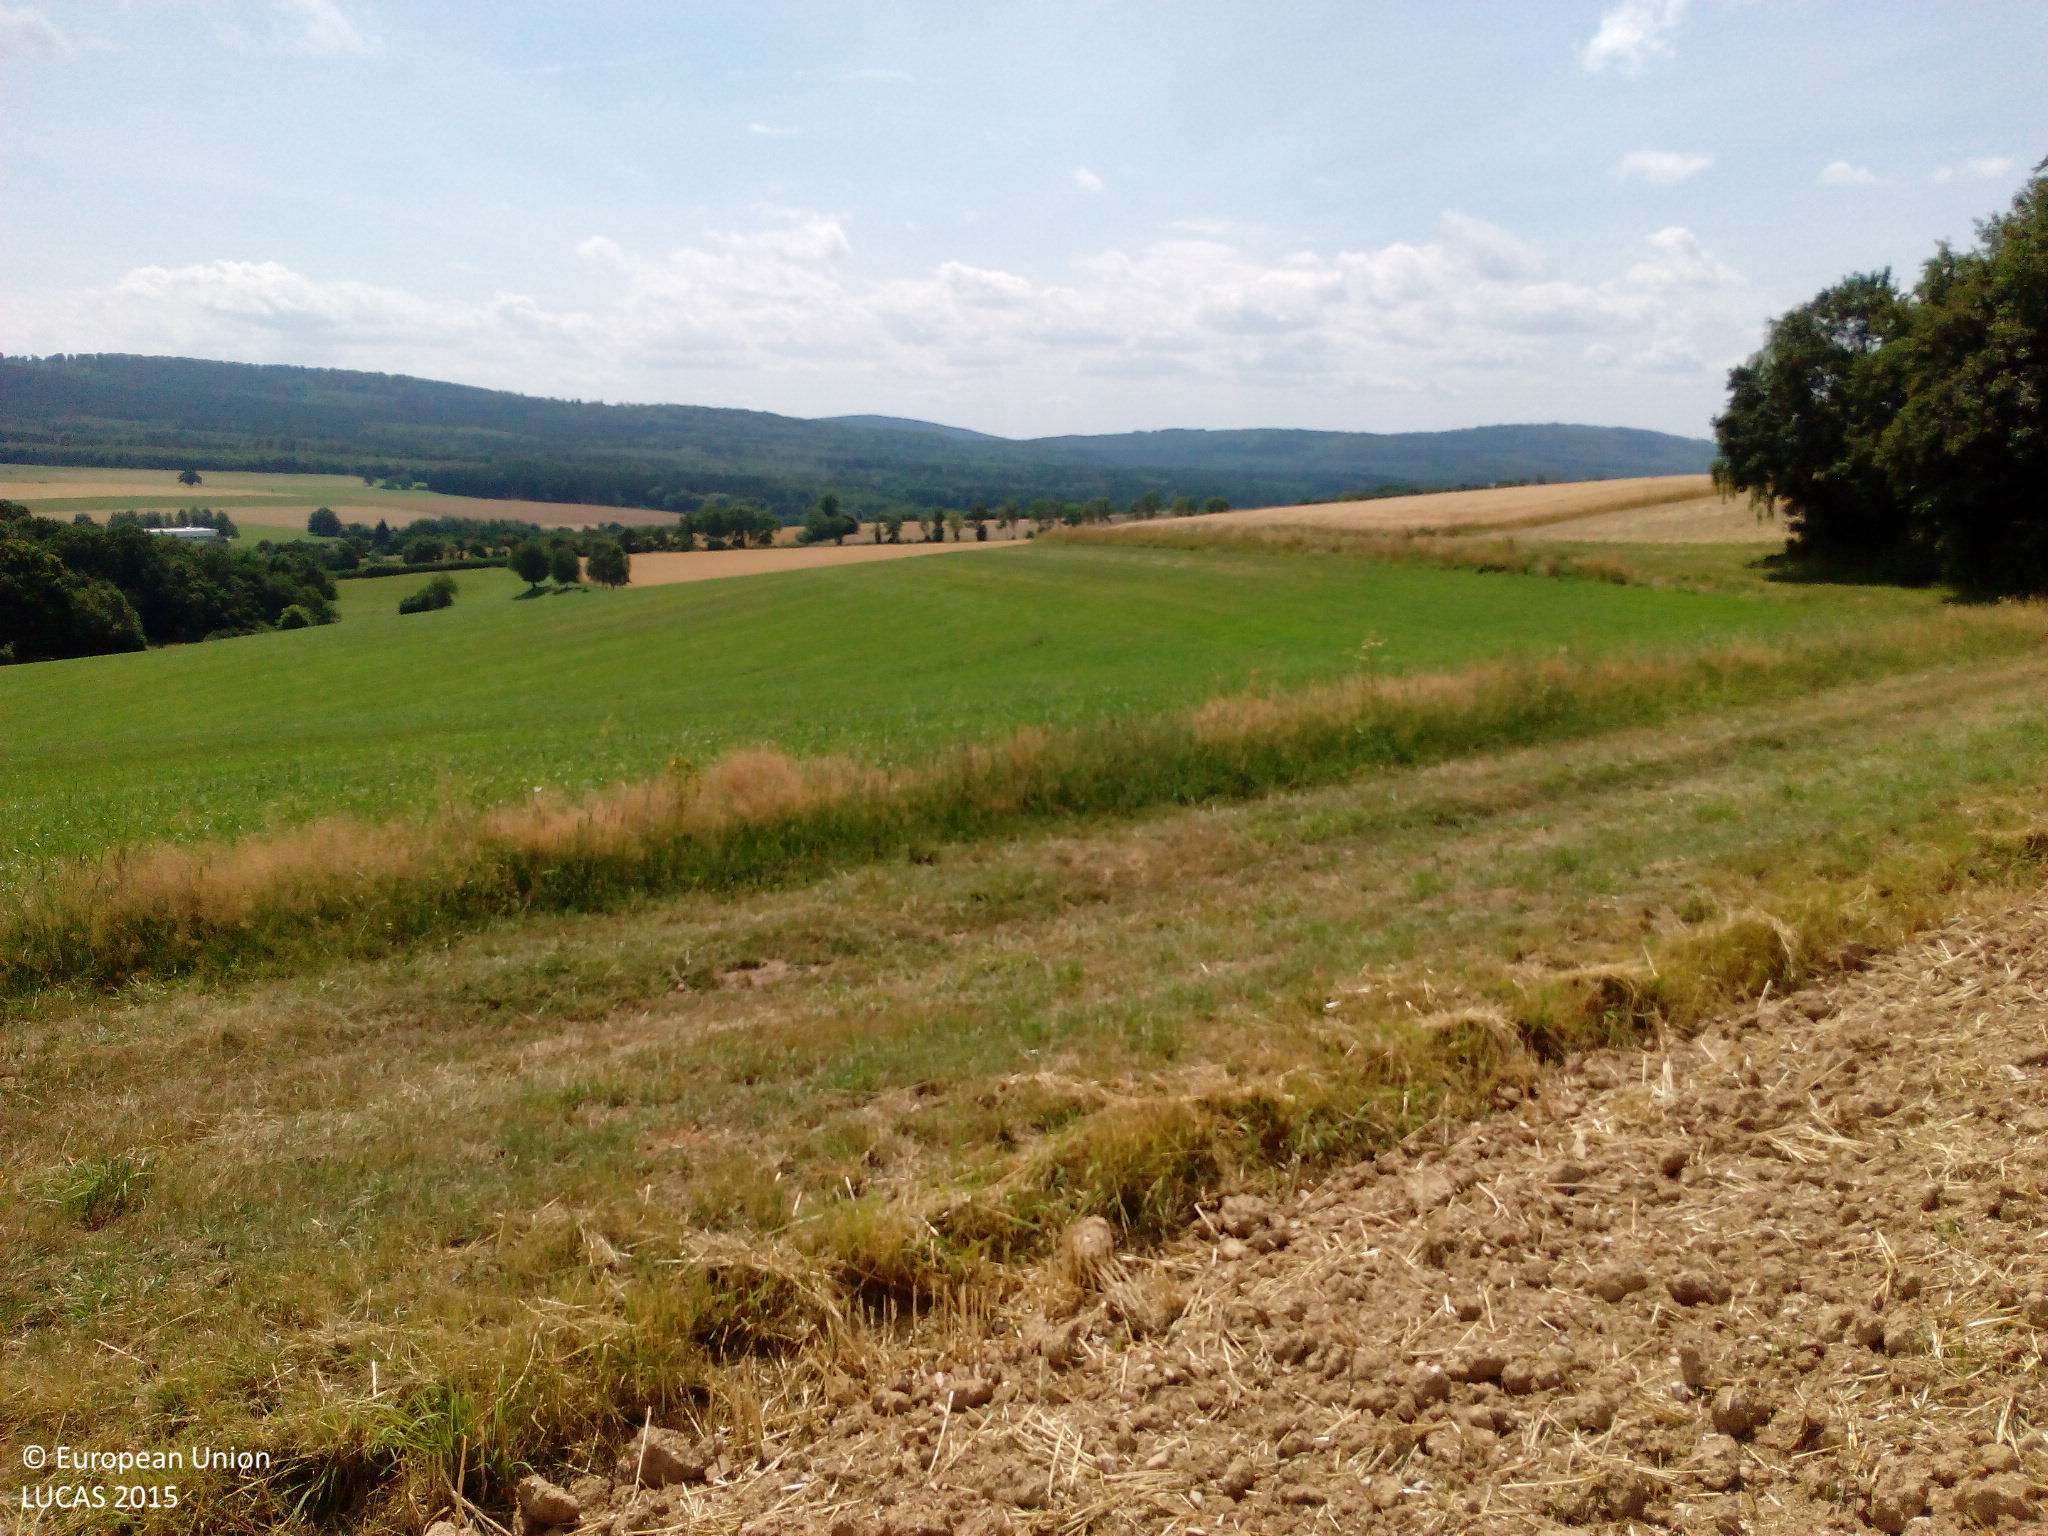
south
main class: Cropland
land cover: Barley
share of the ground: < 10 %
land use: Agriculture (excluding fallow land and kitchen gardens)
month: July
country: DE
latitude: 49.9417
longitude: 7.5340
